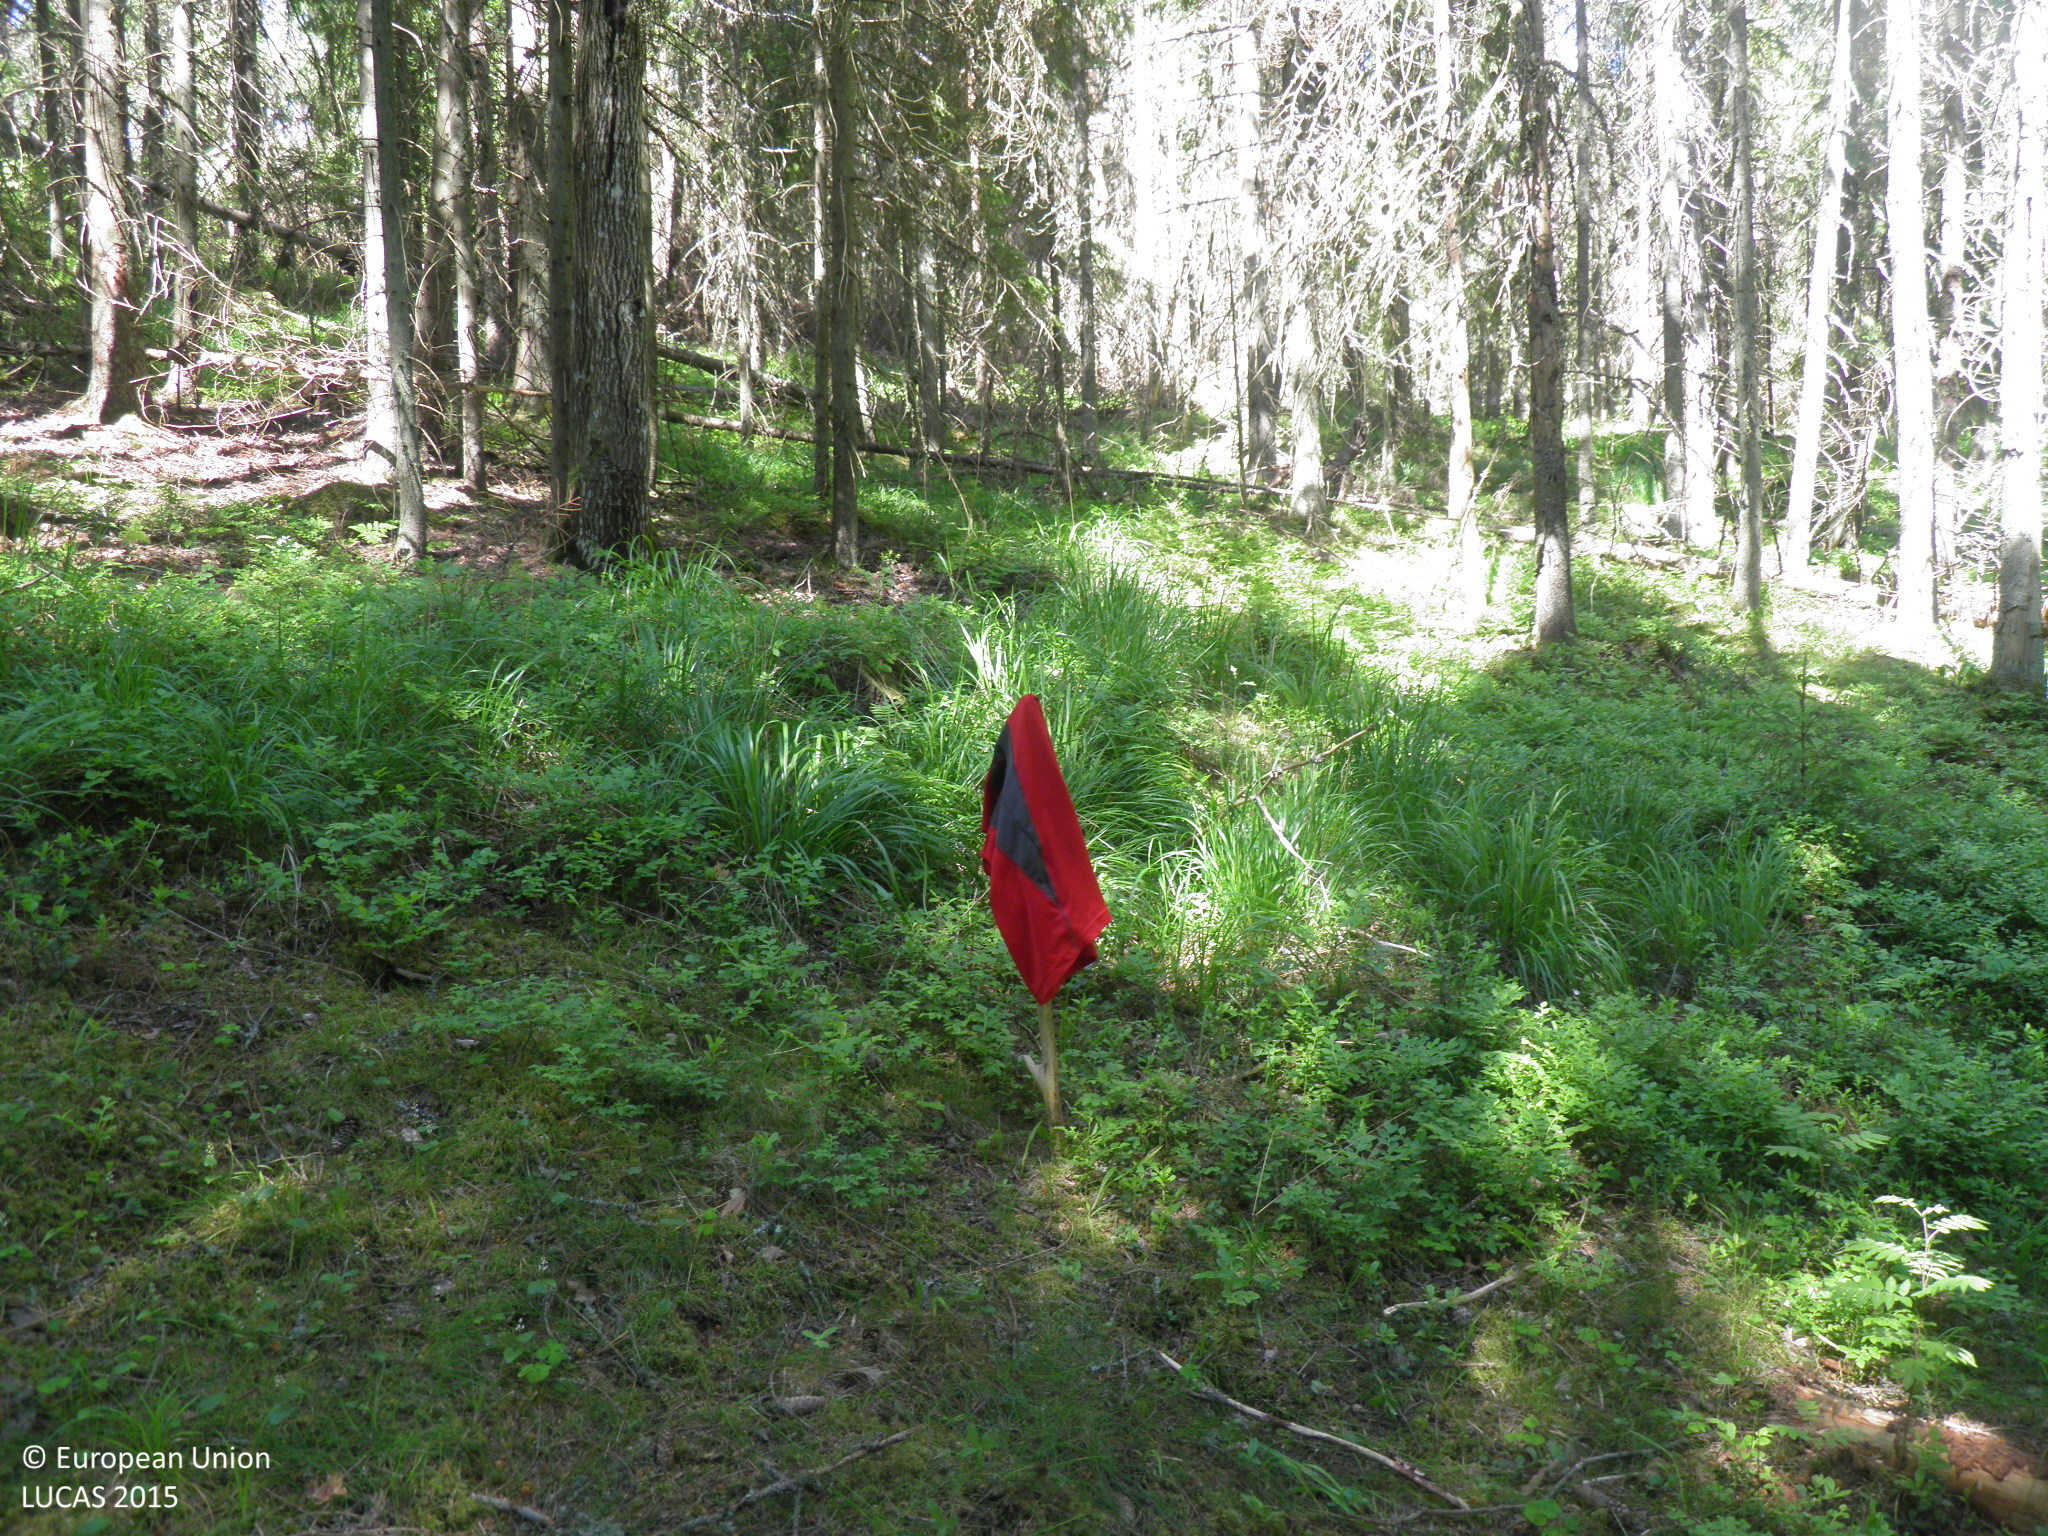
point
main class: Woodland
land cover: Spruce dominated coniferous woodland
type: hemiboreal forest and nemoral coniferous forest and mixed broadleaved-coniferous forest
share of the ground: > 75 %
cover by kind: coniferous forest trees 75 %, broadleaved forest trees 10 %, shrubs 5 %, herbaceous plants 5 %, lichens and mosses 5 %
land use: Semi-natural and natural areas not in use
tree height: > 5 m
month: June
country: FI
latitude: 60.4388
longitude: 22.5551
